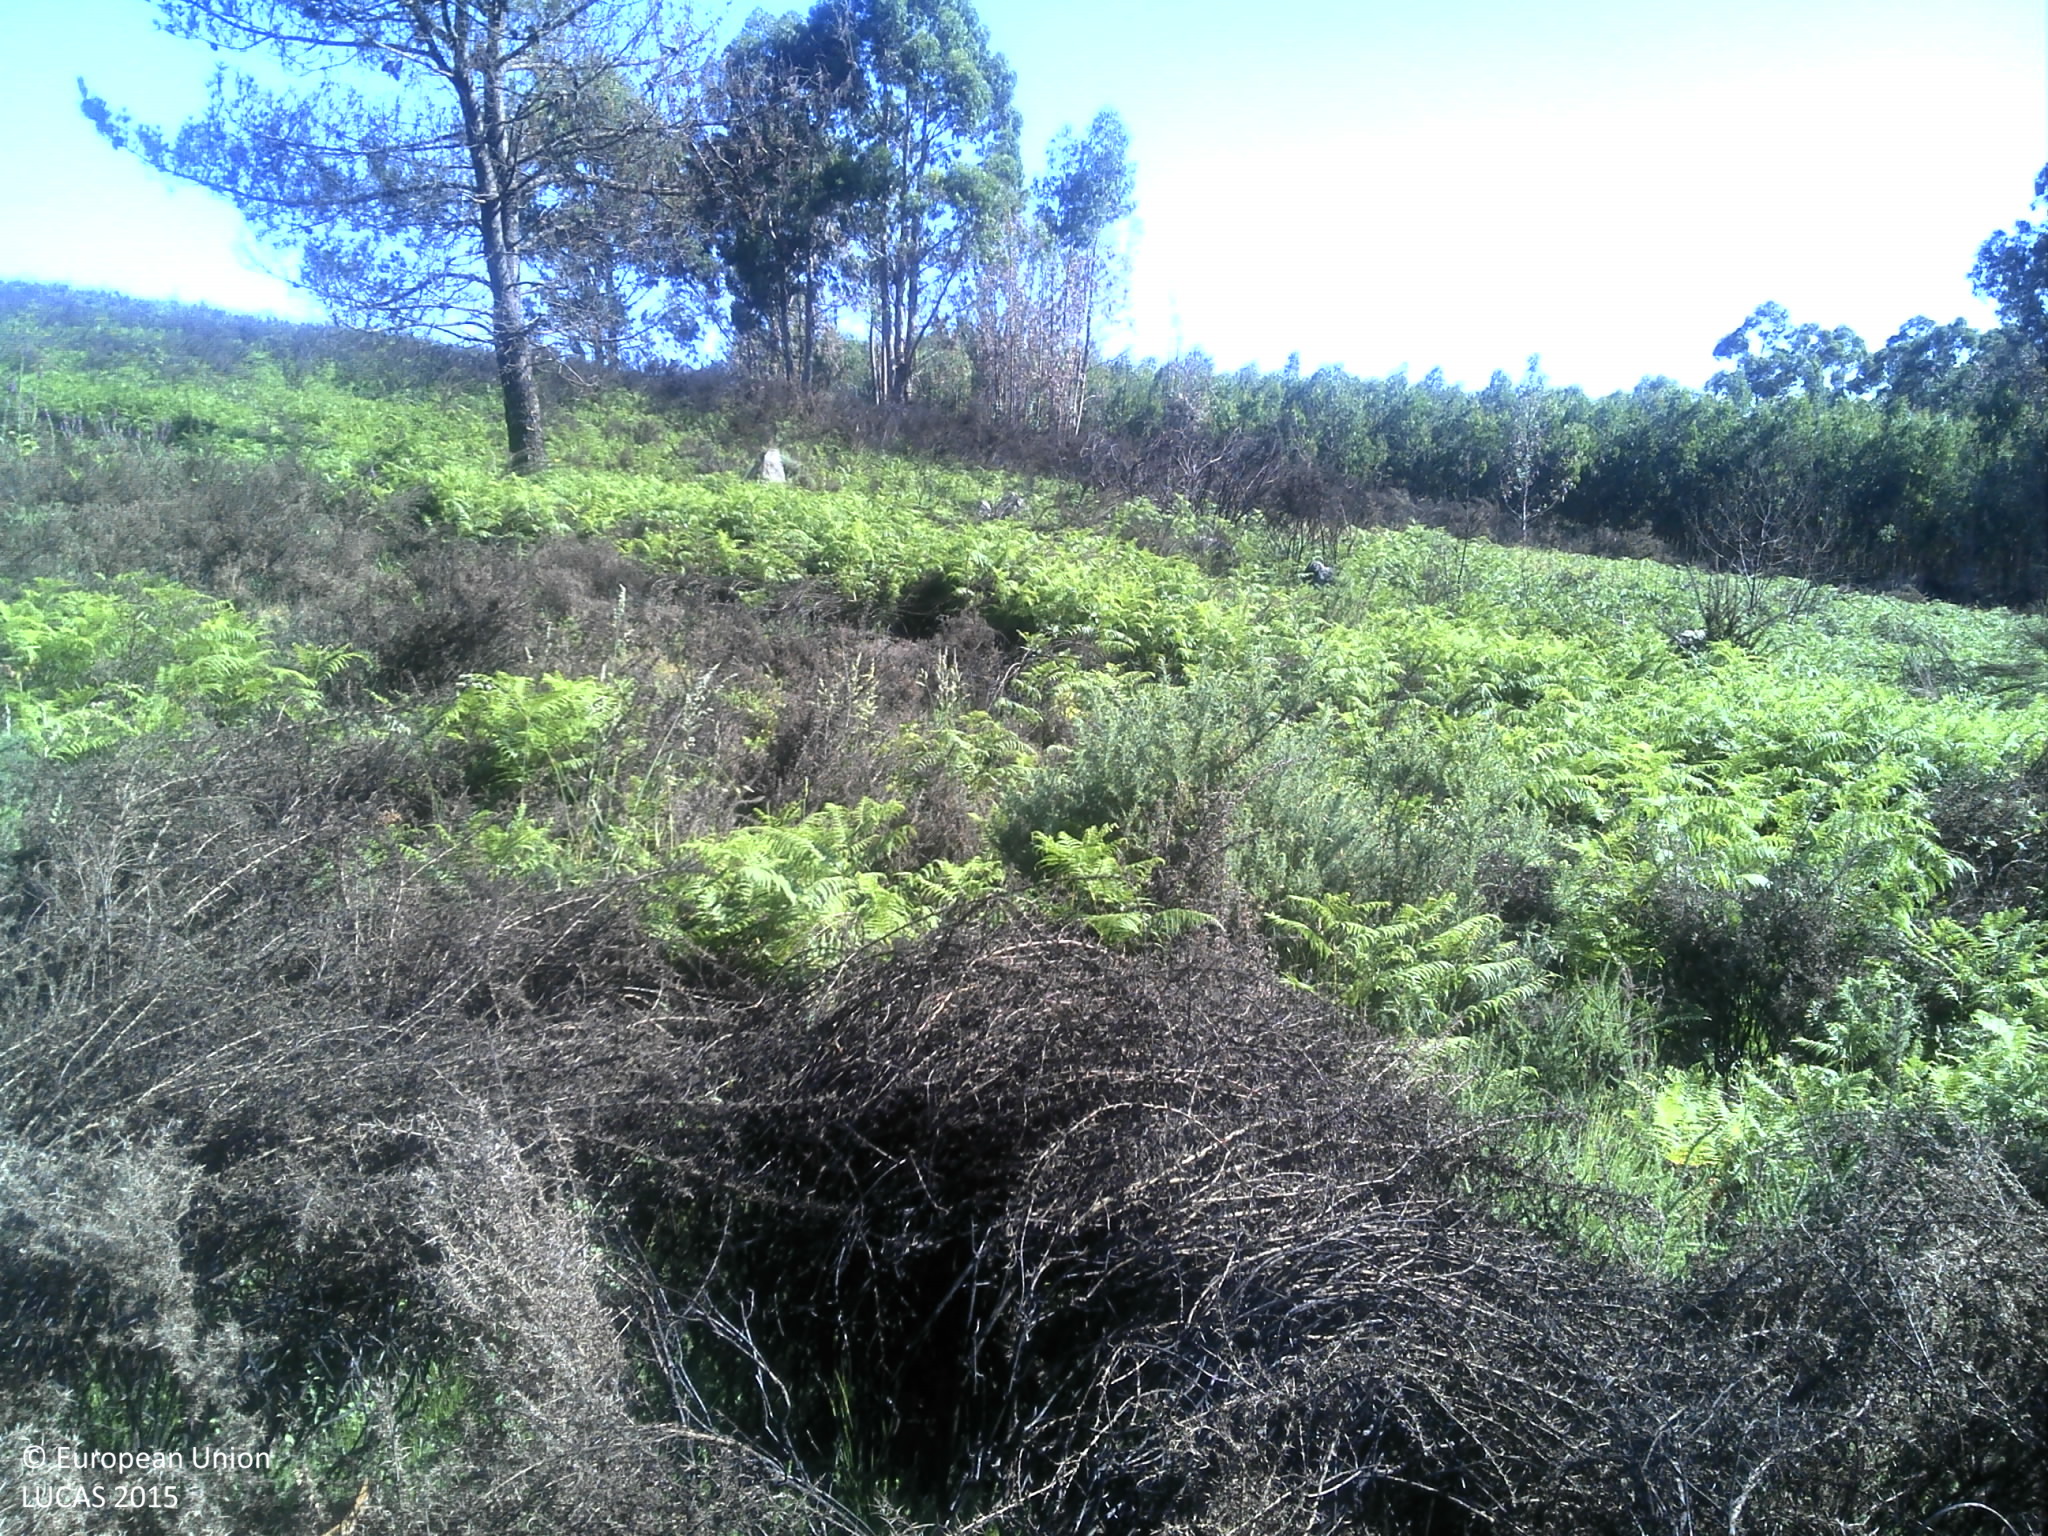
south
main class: Shrubland
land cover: Shrubland without tree cover
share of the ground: > 75 %
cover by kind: shrubs 85 %, herbaceous plants 10 %, unconsolidated bare surface 5 %
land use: Agriculture (excluding fallow land and kitchen gardens)
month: June
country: PT
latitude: 41.4836
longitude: -8.2192
